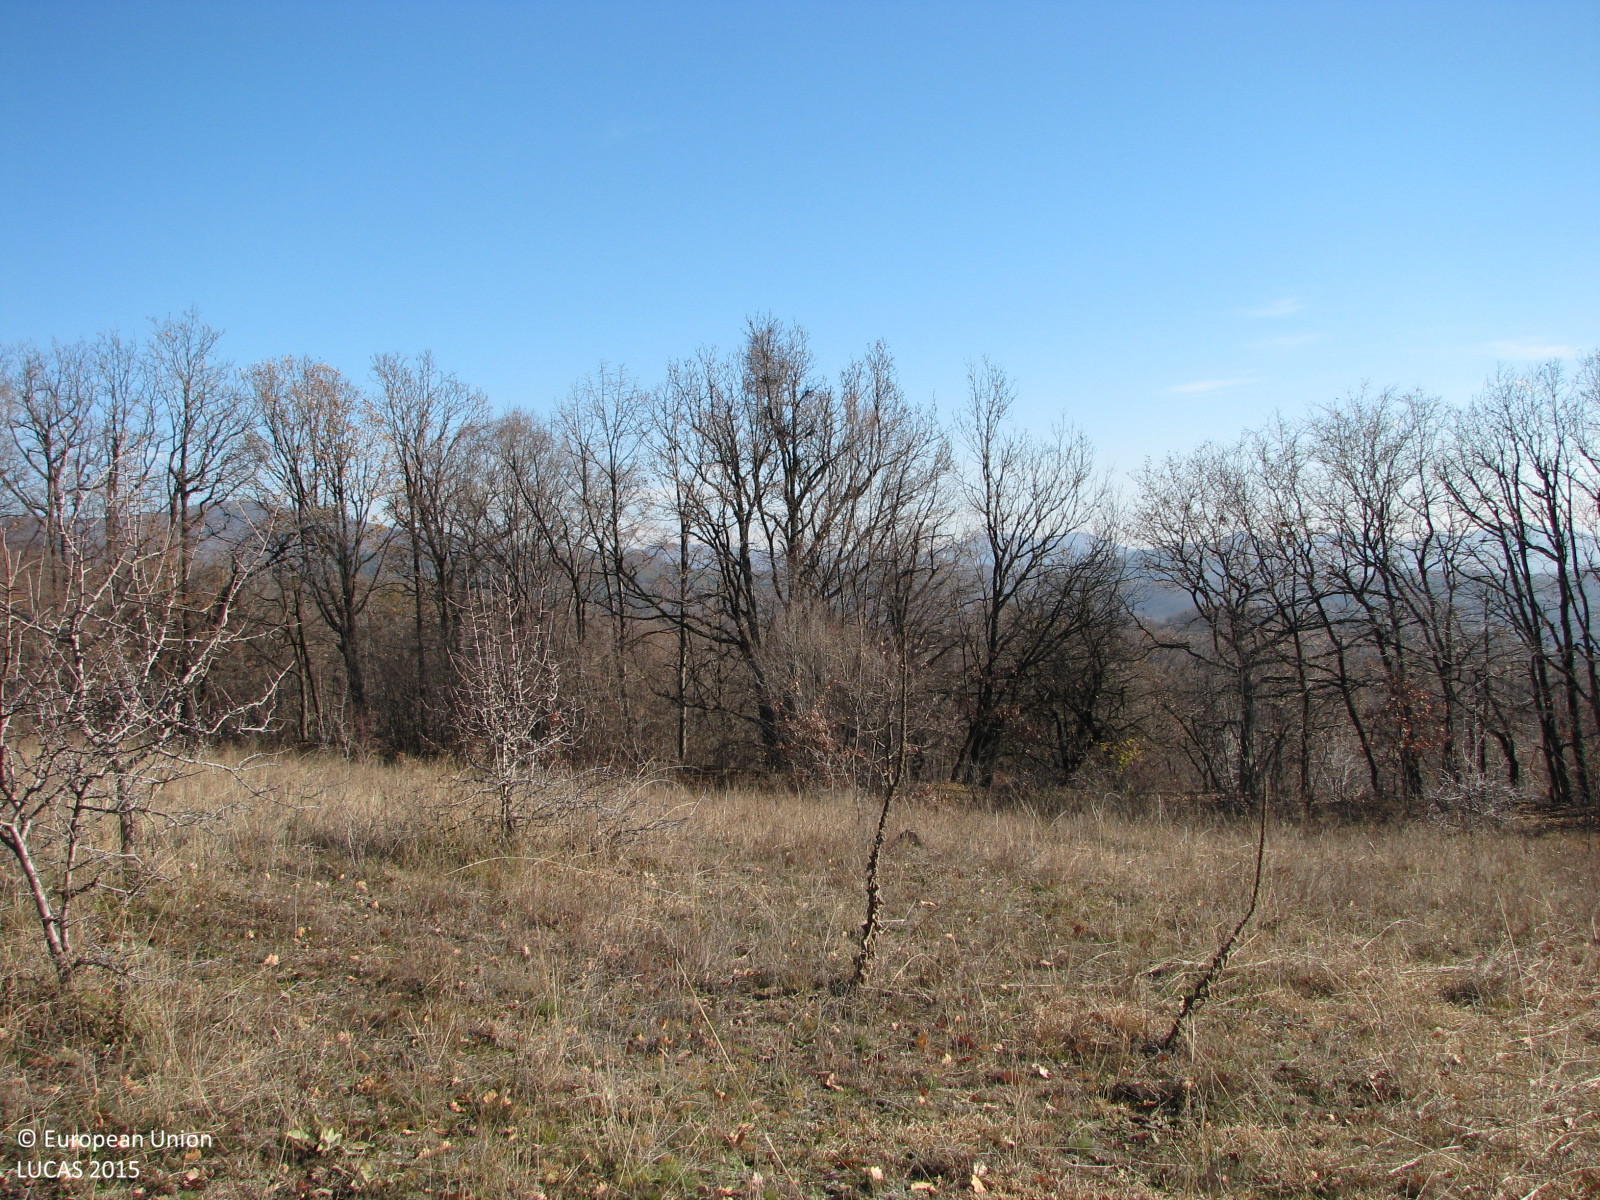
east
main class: Grassland
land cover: Grassland with sparse tree/shrub cover
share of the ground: > 75 %
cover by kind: herbaceous plants 90 %, broadleaved forest trees 5 %, shrubs 5 %
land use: Agriculture (excluding fallow land and kitchen gardens)
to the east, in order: Grassland with sparse tree/shrub cover; Broadleaved woodland; Grassland with sparse tree/shrub cover; Broadleaved woodland; Grassland with sparse tree/shrub cover; Broadleaved woodland
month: December
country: BG
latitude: 42.4815
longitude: 25.0109
